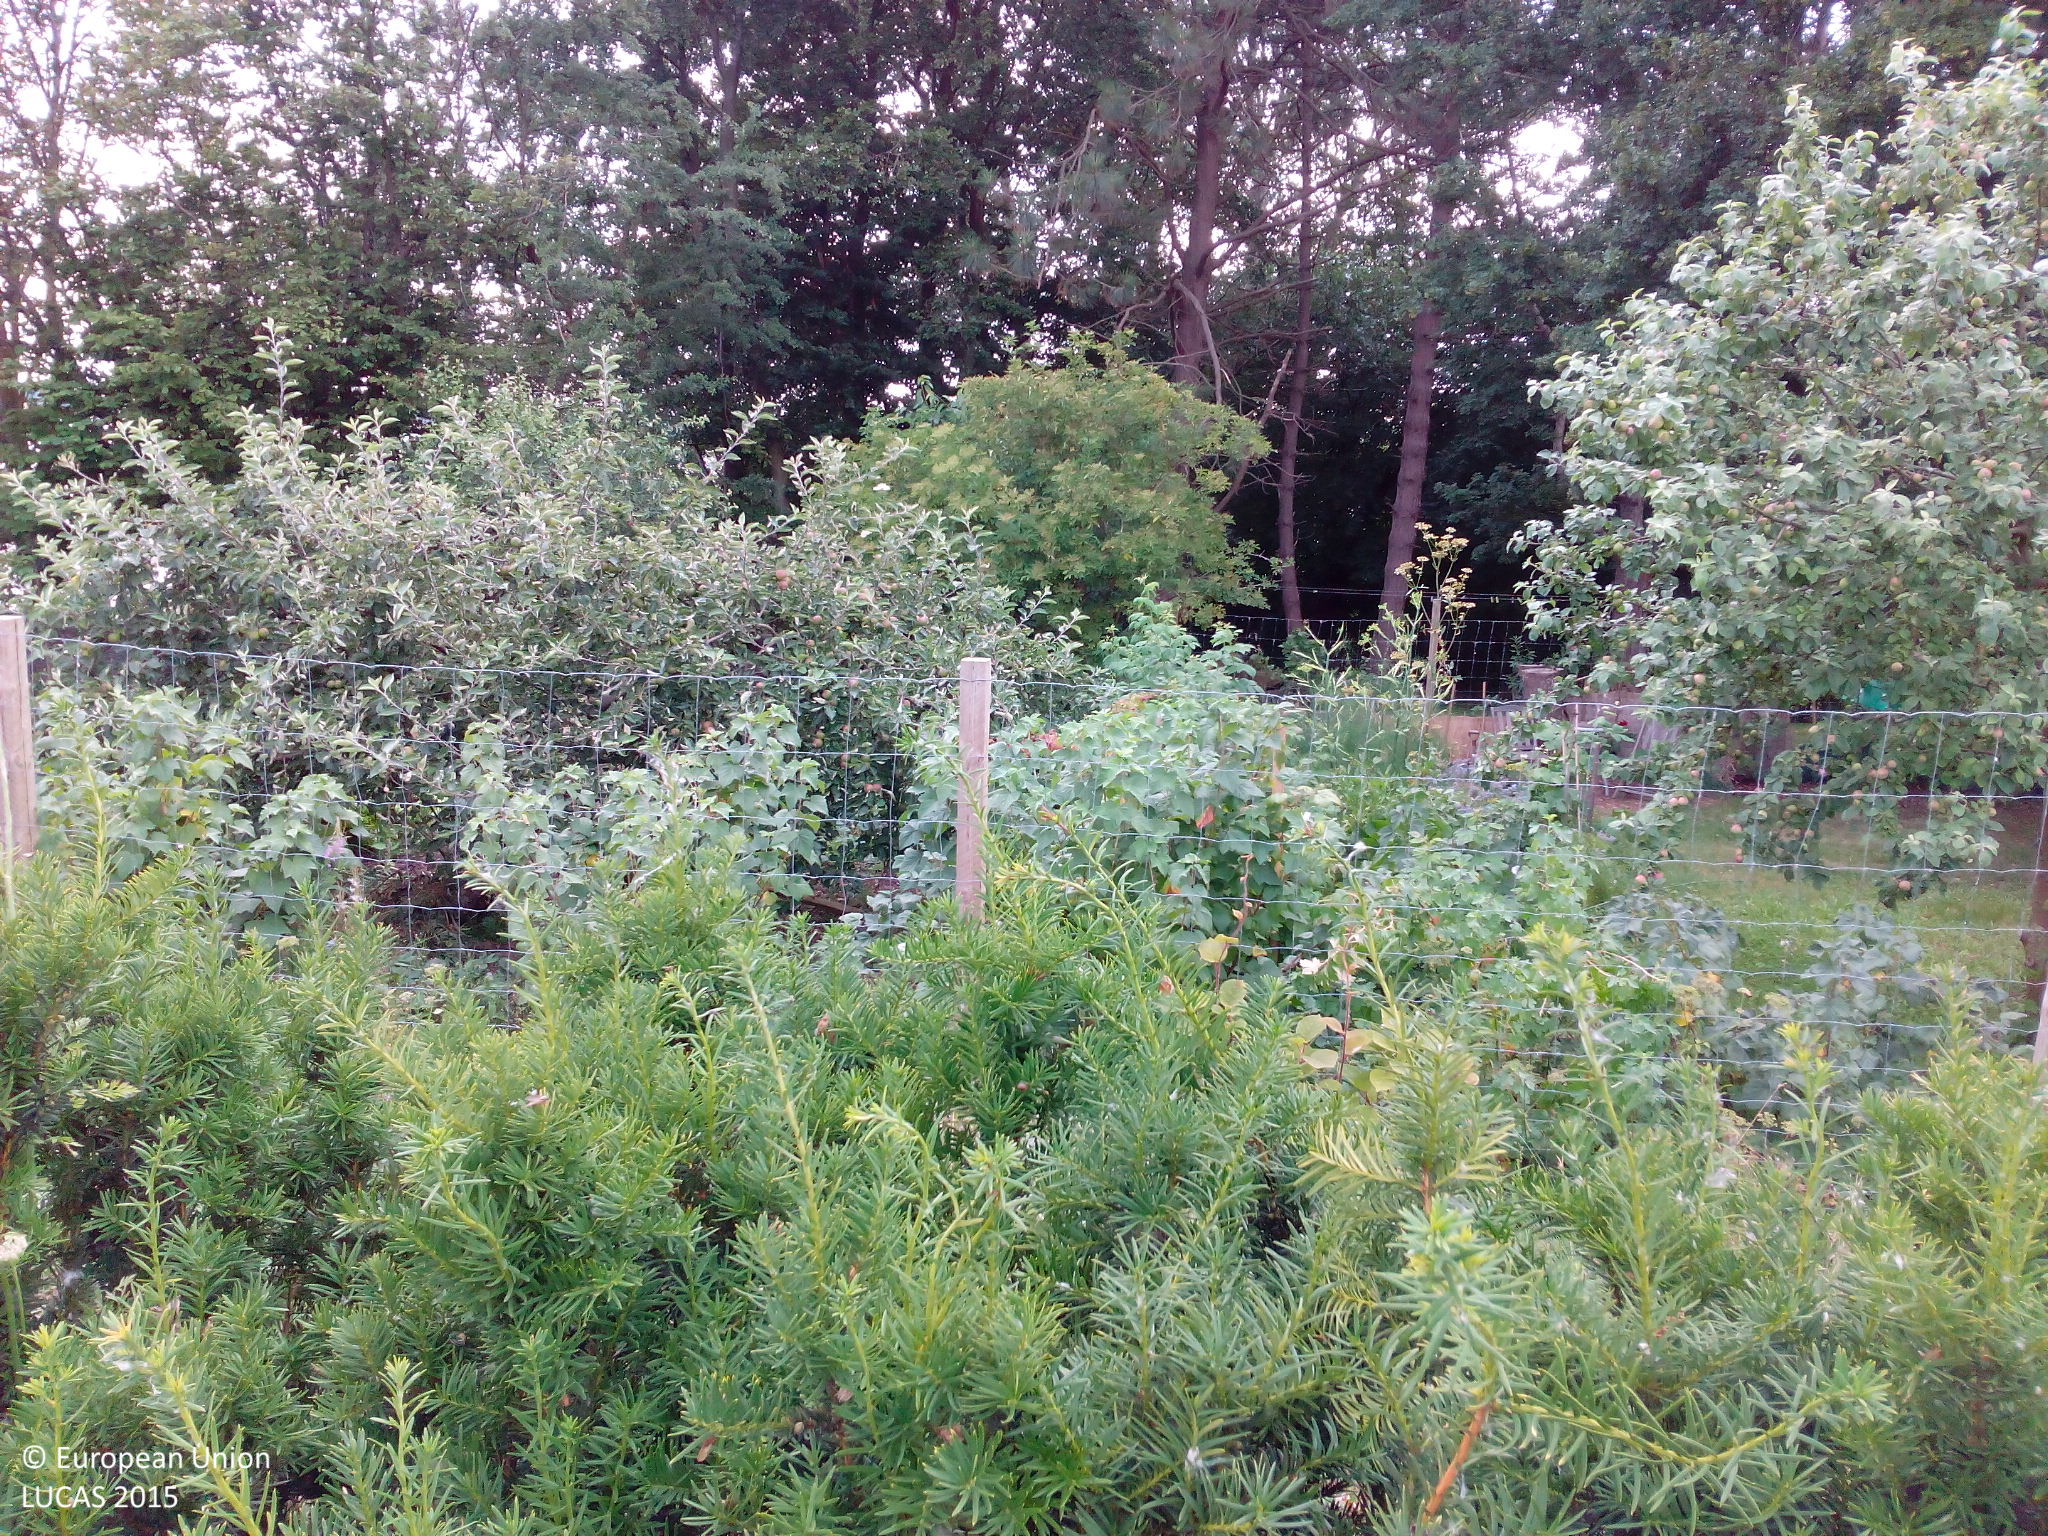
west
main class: Cropland
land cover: Rape and turnip rape
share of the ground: > 75 %
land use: Agriculture (excluding fallow land and kitchen gardens)
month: July
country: DK
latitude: 55.7787
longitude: 11.8637
